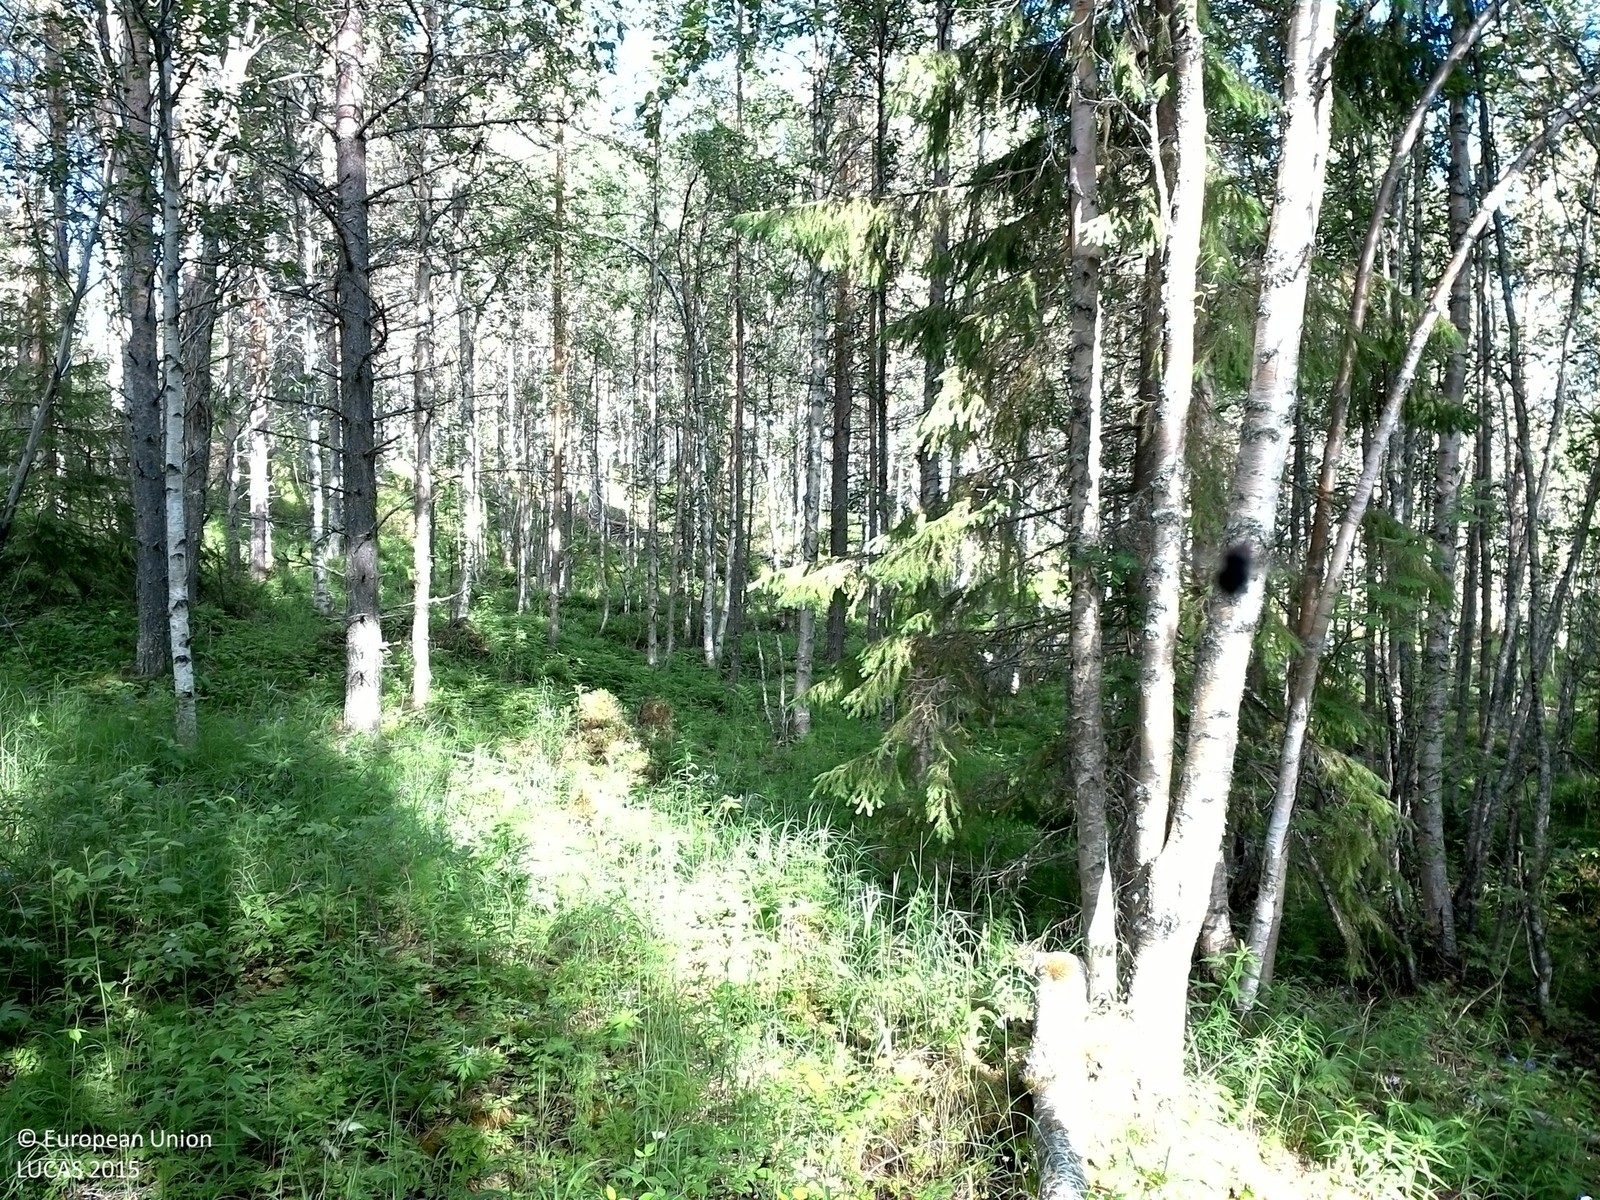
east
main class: Woodland
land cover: Pine dominated mixed woodland
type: boreal forest
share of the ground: 50 - 75 %
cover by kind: coniferous forest trees 35 %, broadleaved forest trees 25 %, herbaceous plants 25 %, shrubs 10 %, lichens and mosses 5 %
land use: Forestry
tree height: > 5 m
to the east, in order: Pine dominated mixed woodland; Pine dominated coniferous woodland; Pine dominated mixed woodland
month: July
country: SE
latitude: 64.5909
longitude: 15.5465
